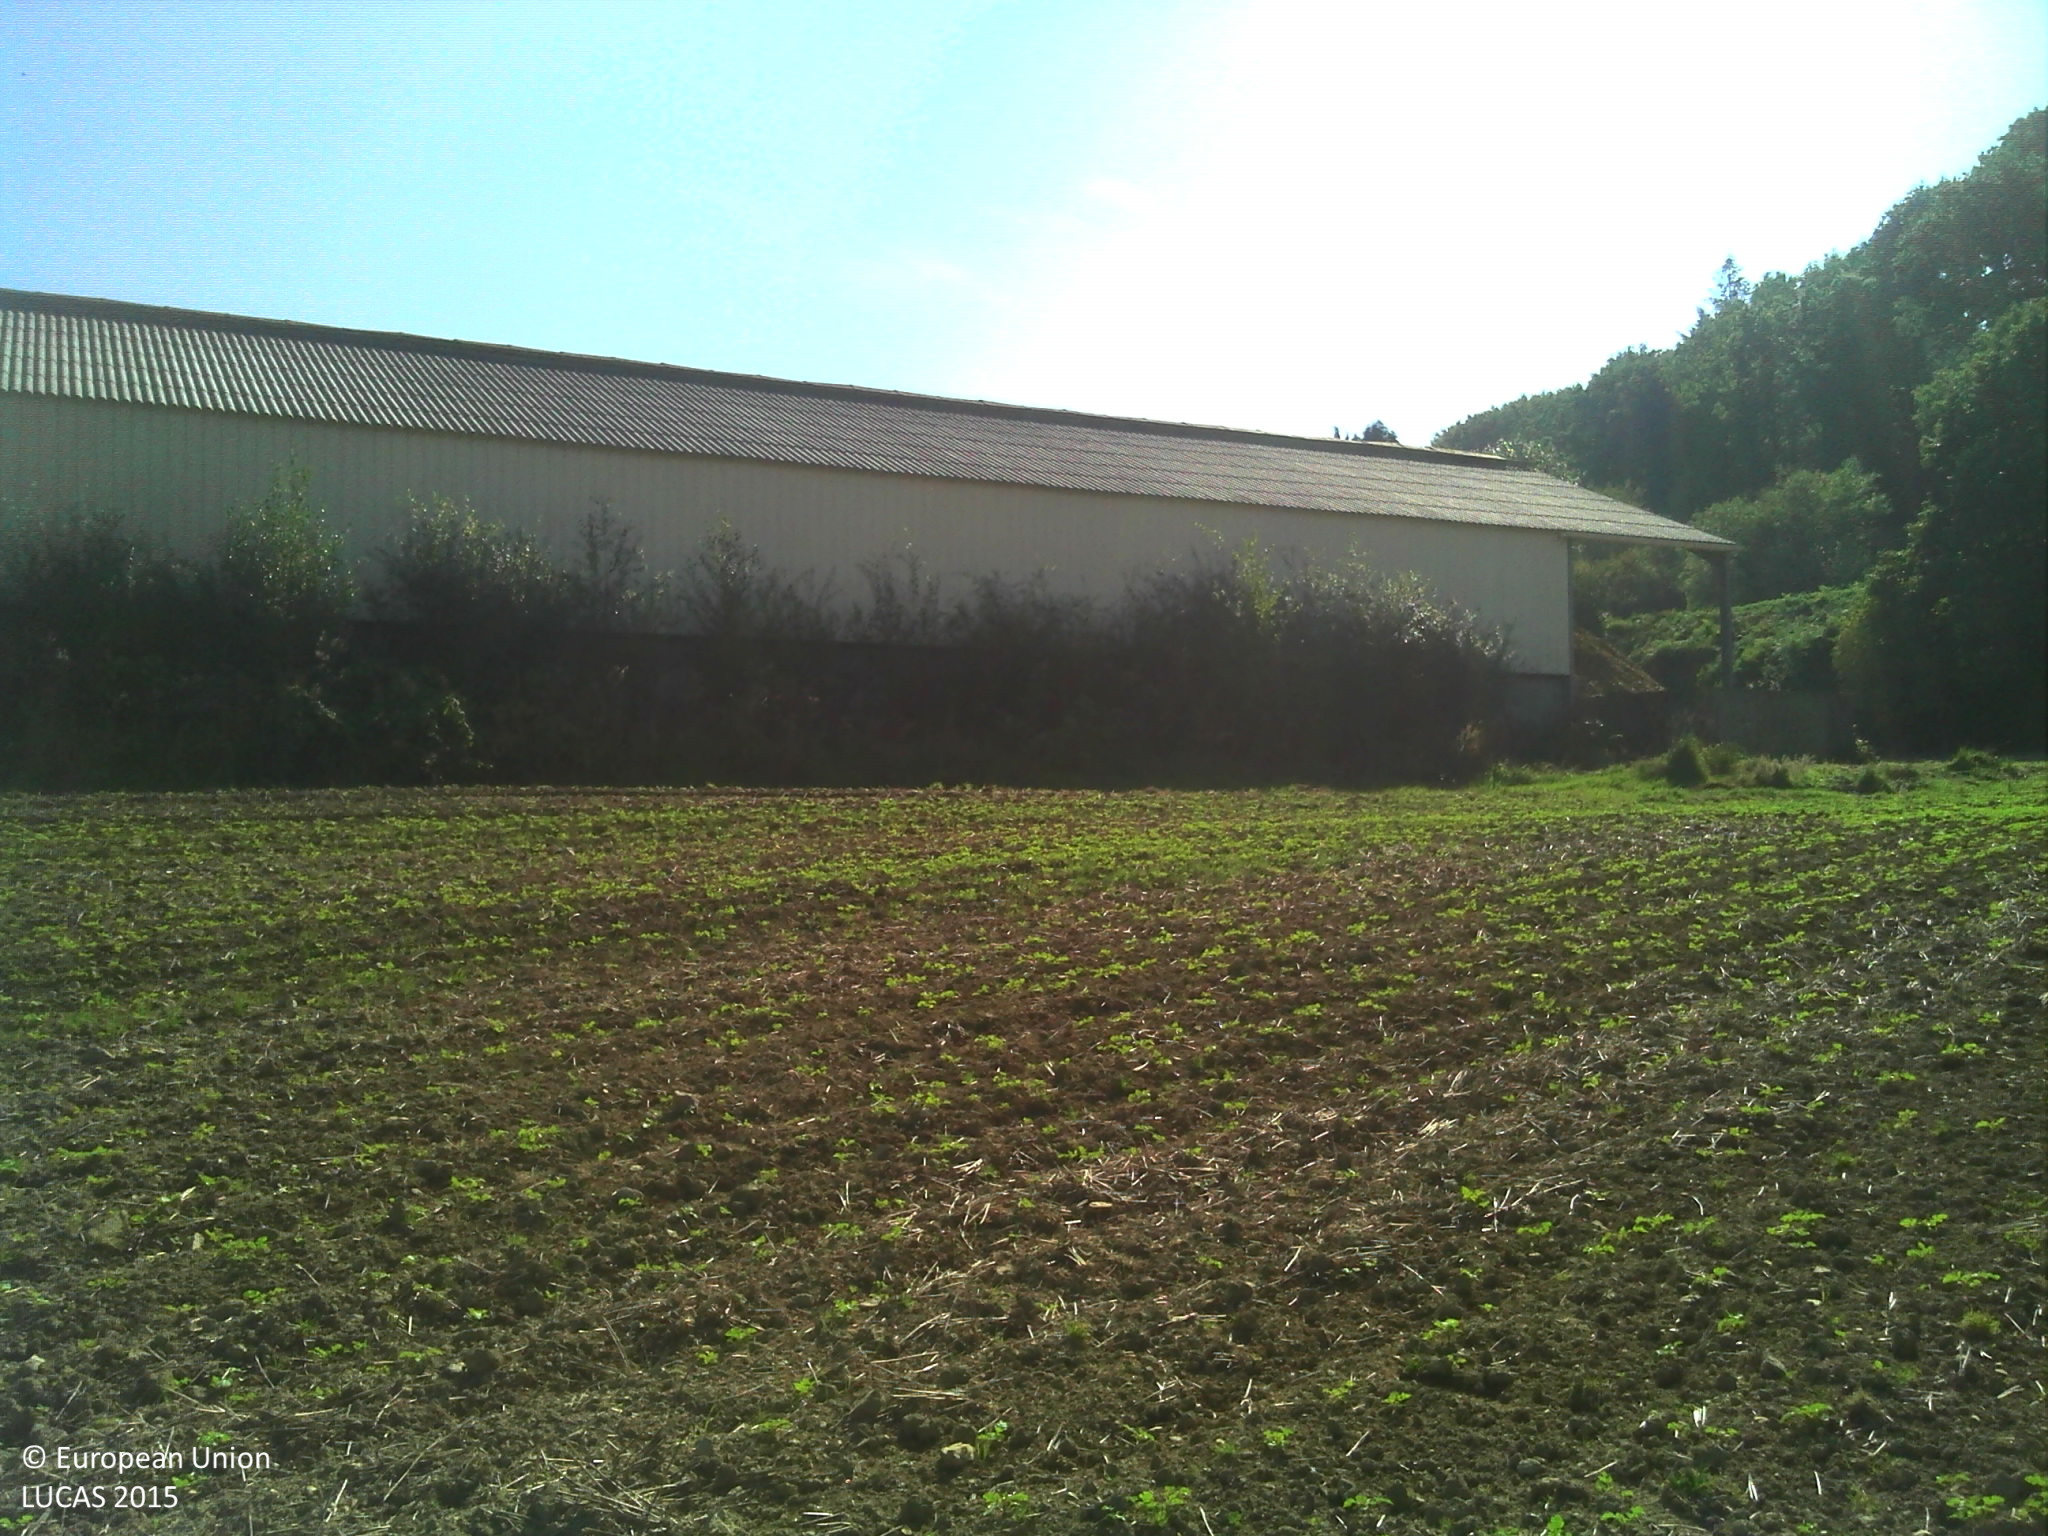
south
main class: Cropland
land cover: Rape and turnip rape
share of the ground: 10 - 25 %
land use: Agriculture (excluding fallow land and kitchen gardens)
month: October
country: FR
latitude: 48.4560
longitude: -3.1206
